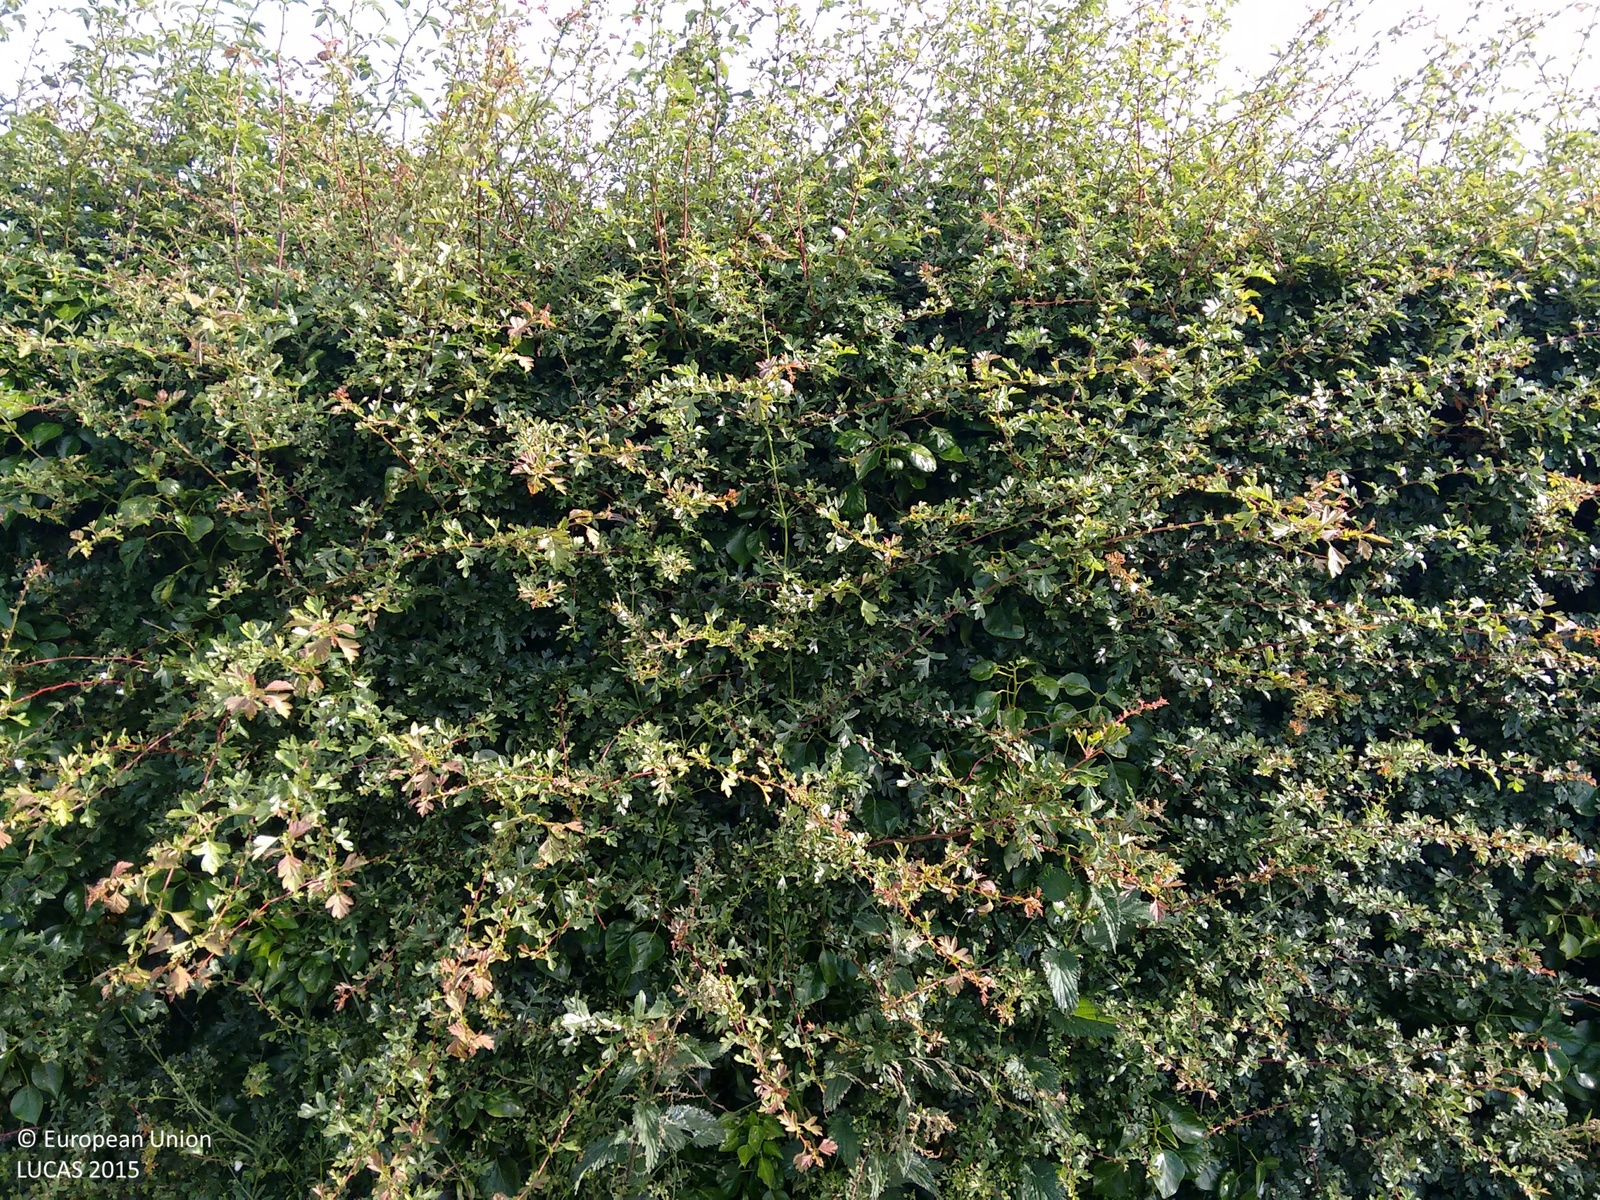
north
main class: Cropland
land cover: Common wheat
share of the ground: 50 - 75 %
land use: Agriculture (excluding fallow land and kitchen gardens)
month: June
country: GB
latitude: 50.8239
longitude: -0.8742
